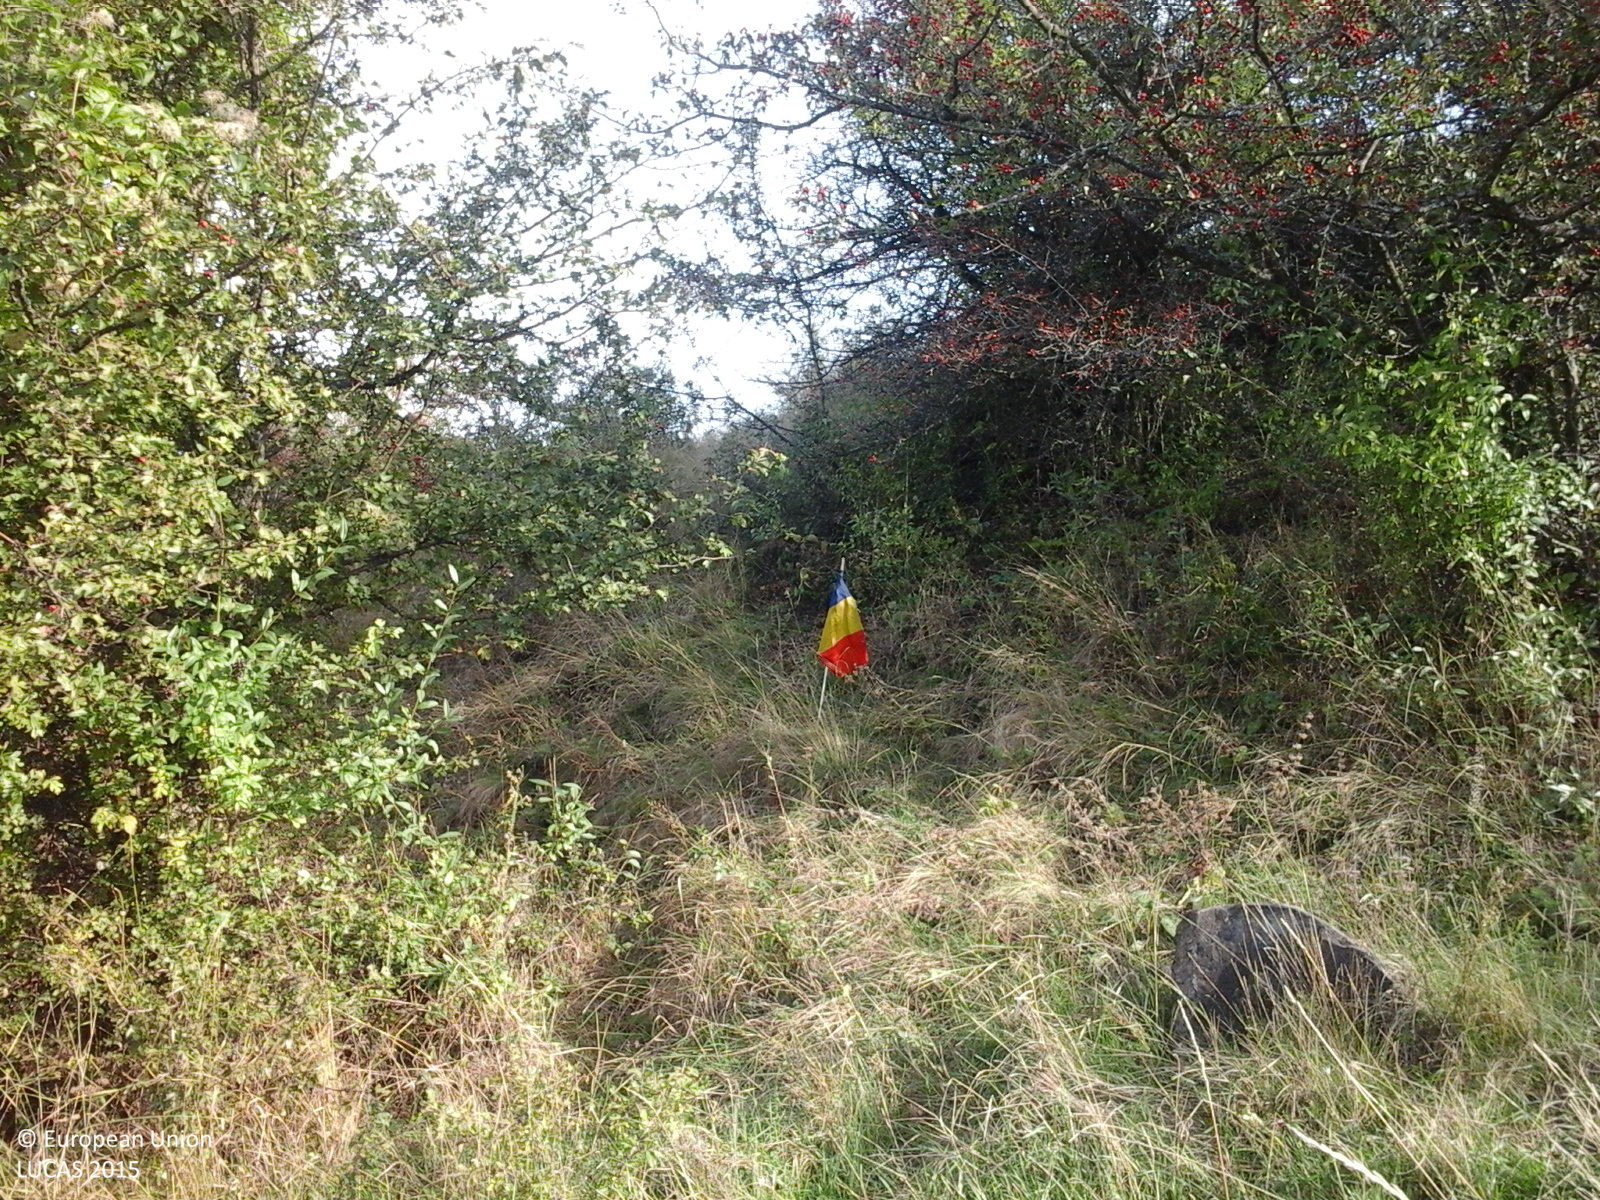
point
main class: Shrubland
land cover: Shrubland with sparse tree cover
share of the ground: > 75 %
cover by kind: herbaceous plants 85 %, shrubs 10 %, broadleaved forest trees 5 %
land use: Agriculture (excluding fallow land and kitchen gardens)
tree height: > 5 m
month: September
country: RO
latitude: 46.8593
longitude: 23.3547
